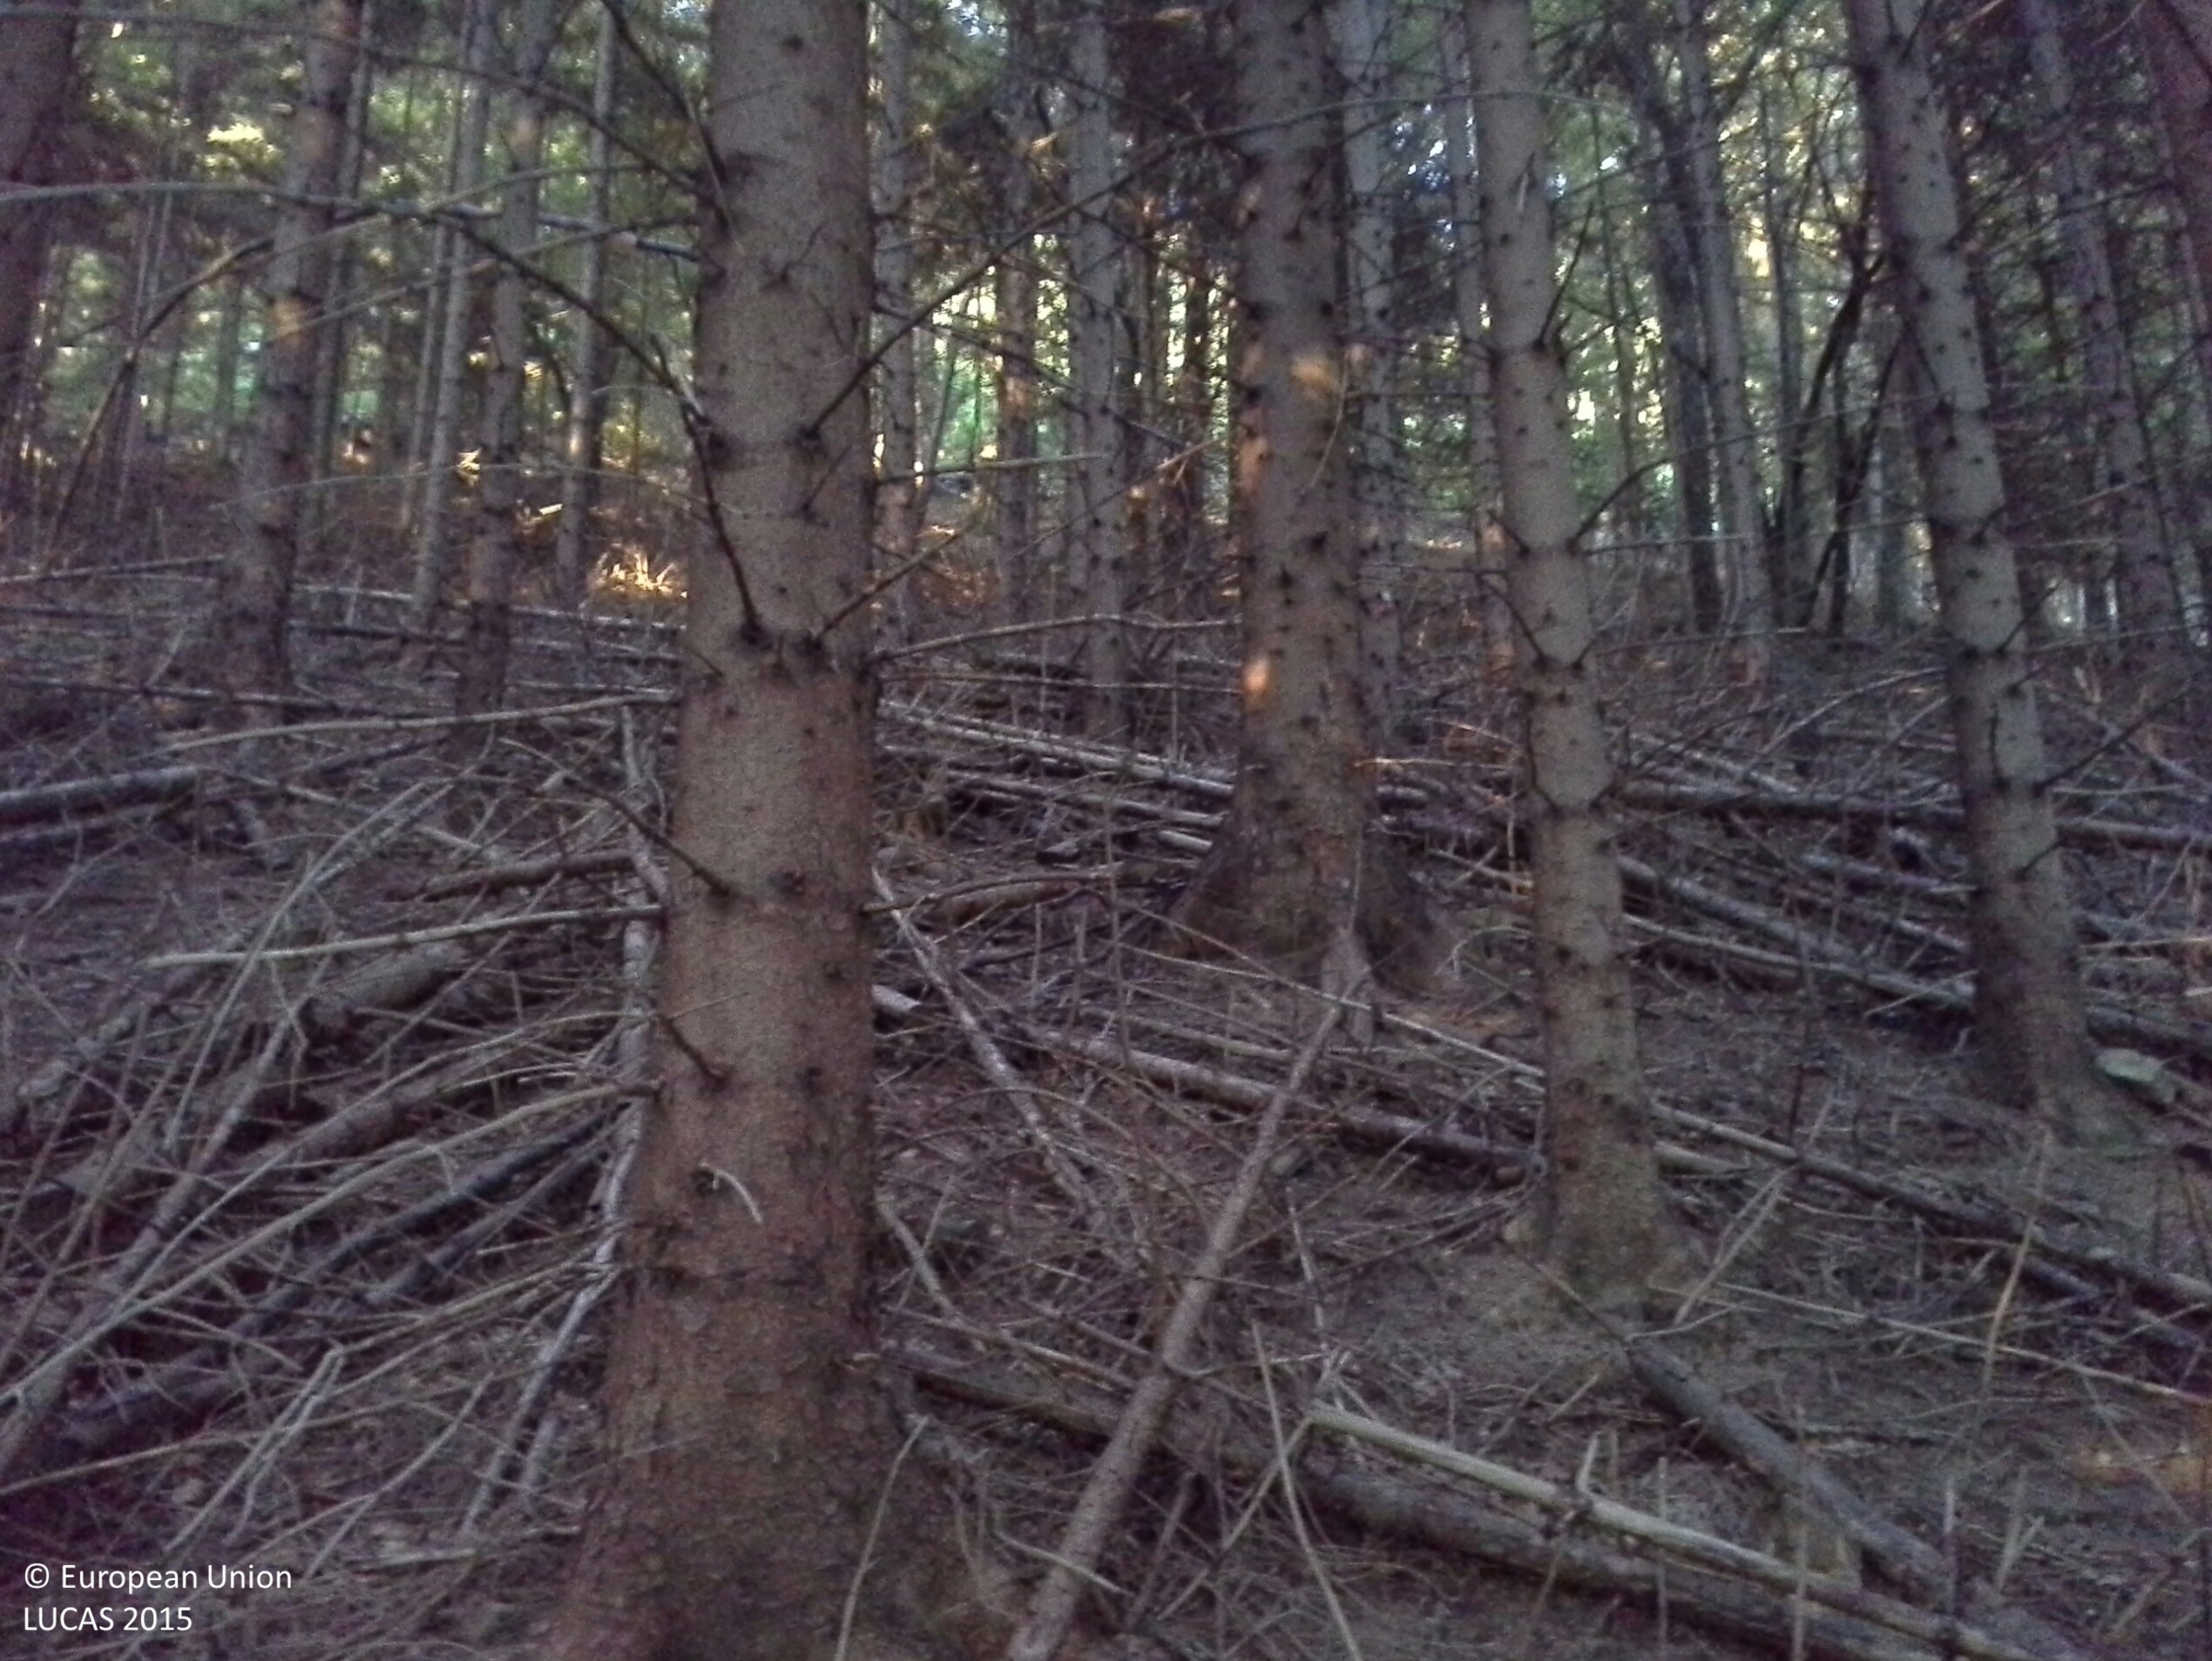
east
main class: Woodland
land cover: Spruce dominated coniferous woodland
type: alpine coniferous forest
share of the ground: > 75 %
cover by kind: coniferous forest trees 100 %
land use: Forestry
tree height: > 5 m
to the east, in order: Spruce dominated coniferous woodland; Spruce dominated mixed woodland; Tracks; Shrubland with sparse tree cover; Broadleaved woodland; Other mixed woodland; Spruce dominated mixed woodland; Other mixed woodland; Broadleaved woodland
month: July
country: AT
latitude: 47.9308
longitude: 14.5642
